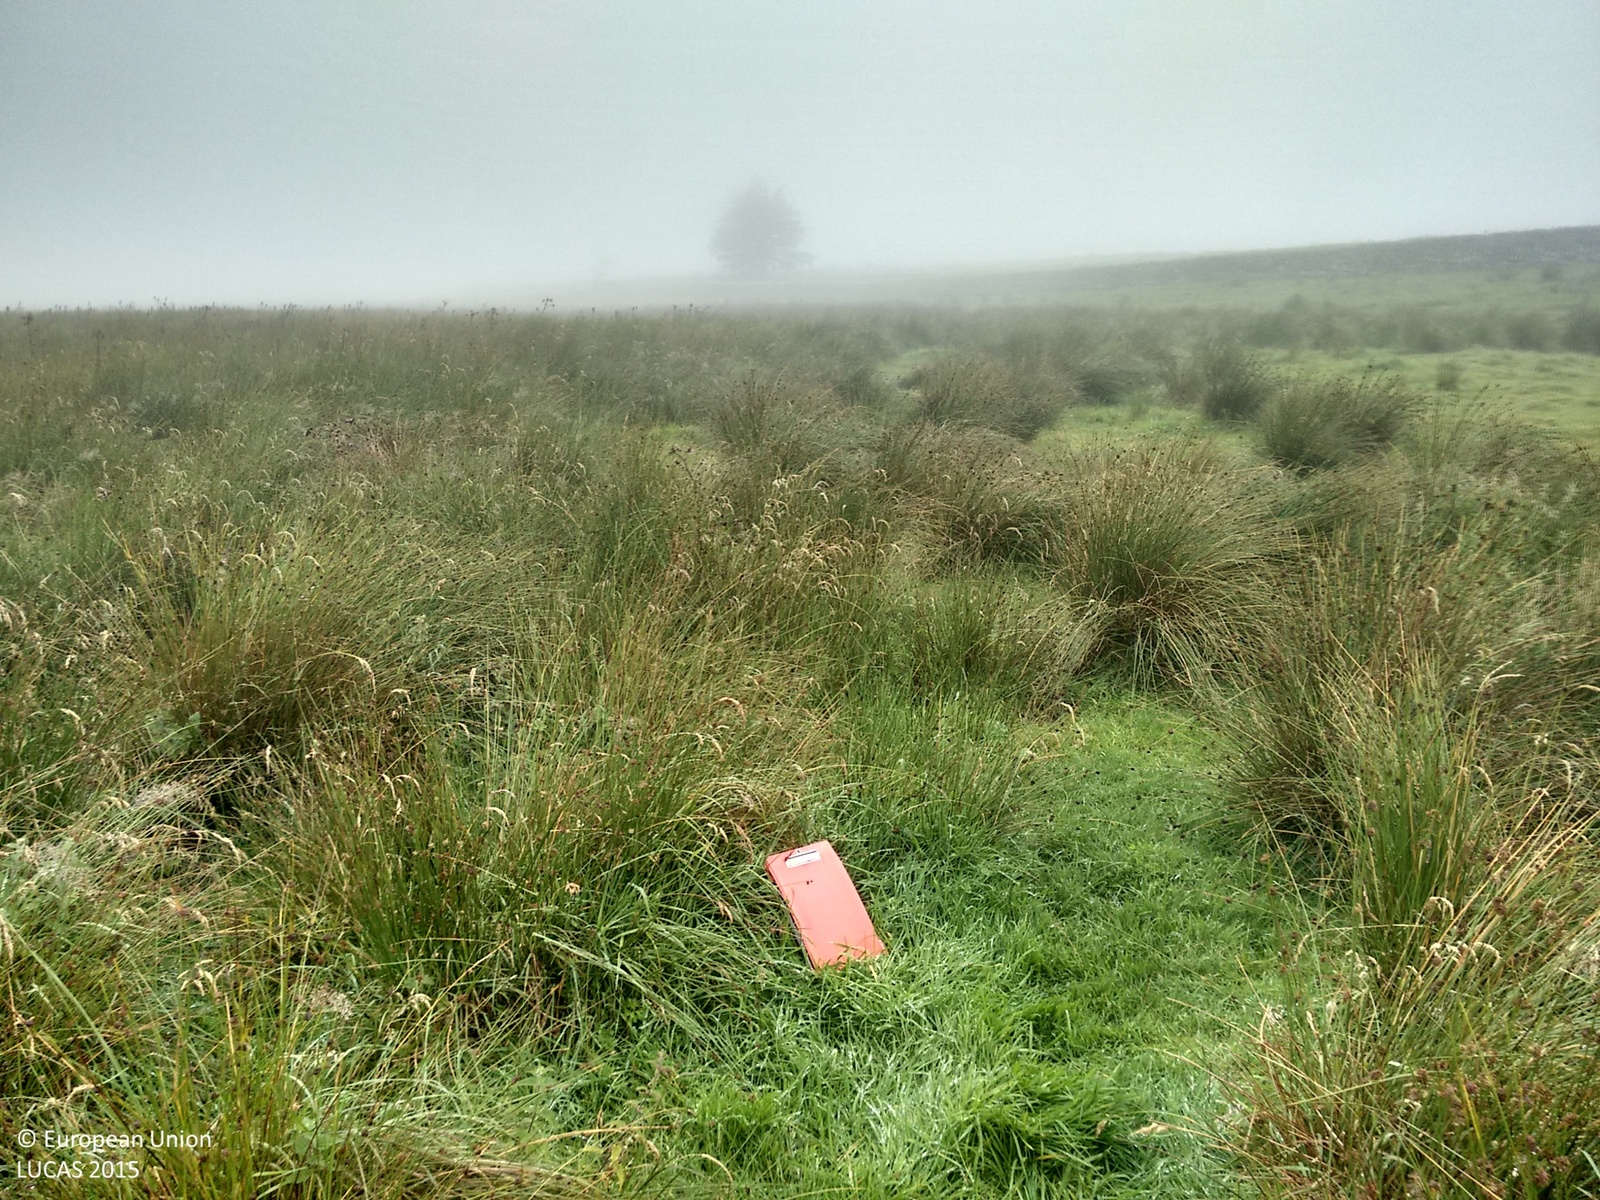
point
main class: Grassland
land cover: Grassland without tree/shrub cover
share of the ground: > 75 %
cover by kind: herbaceous plants 100 %
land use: Agriculture (excluding fallow land and kitchen gardens)
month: August
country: GB
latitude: 50.5567
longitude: -3.9972
